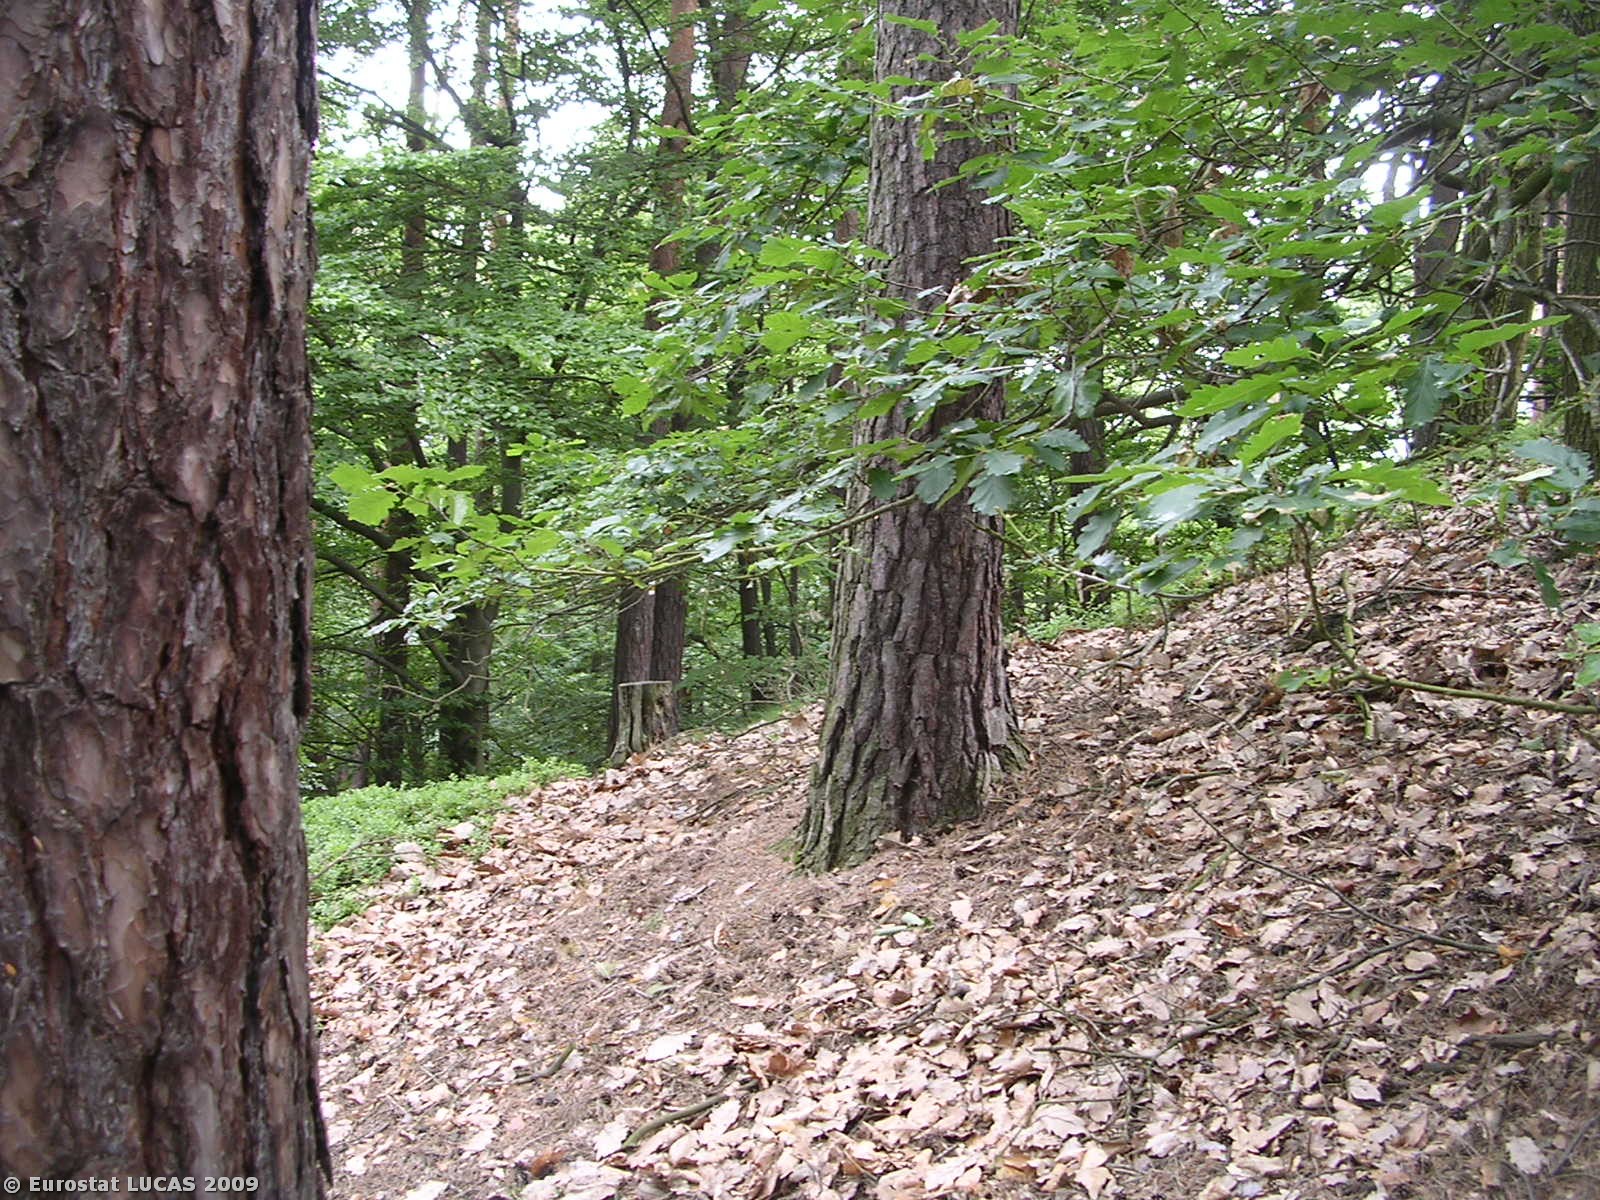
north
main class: Woodland
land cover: Mixed woodland
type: hemiboreal forest and nemoral coniferous forest and mixed broadleaved-coniferous forest
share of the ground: > 75 %
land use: Forestry
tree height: > 5 m
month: June
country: CZ
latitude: 50.5086
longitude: 14.5282
